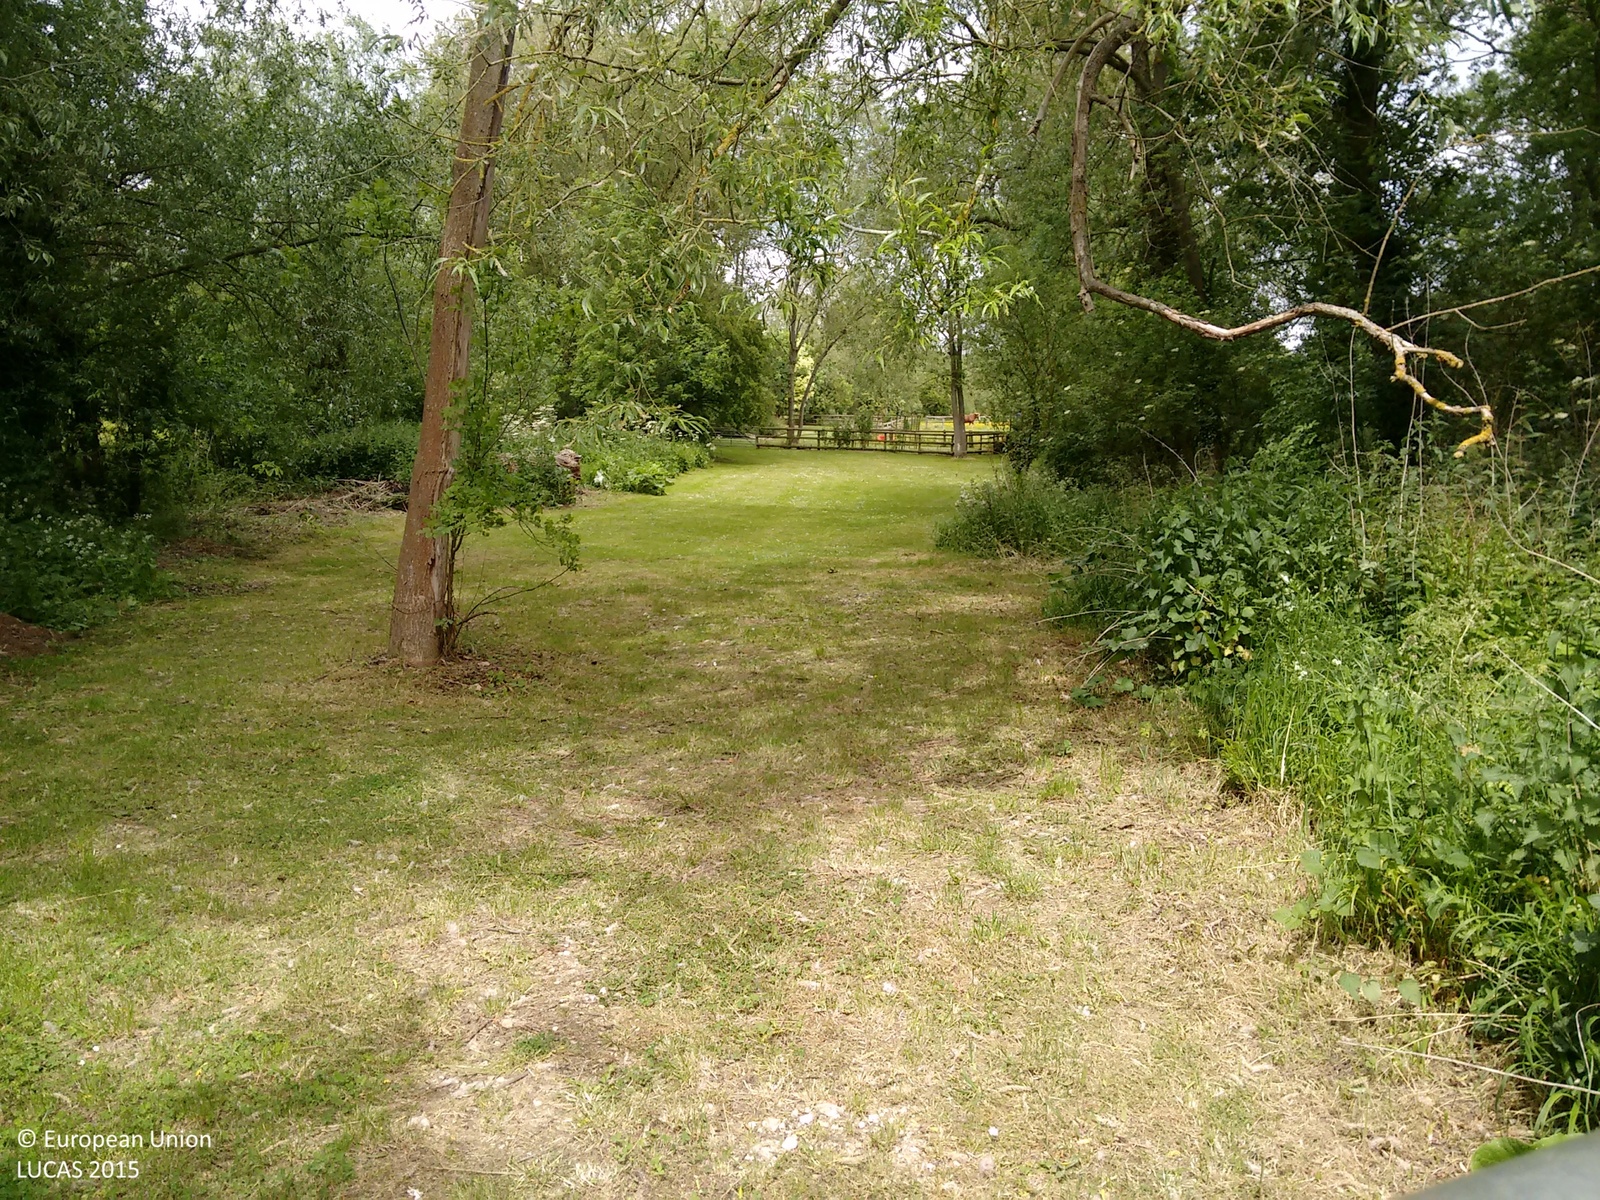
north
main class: Grassland
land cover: Grassland with sparse tree/shrub cover
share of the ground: > 75 %
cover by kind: herbaceous plants 95 %, broadleaved forest trees 5 %
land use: Agriculture (excluding fallow land and kitchen gardens)
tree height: > 5 m
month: June
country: GB
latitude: 52.1122
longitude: -1.6327
